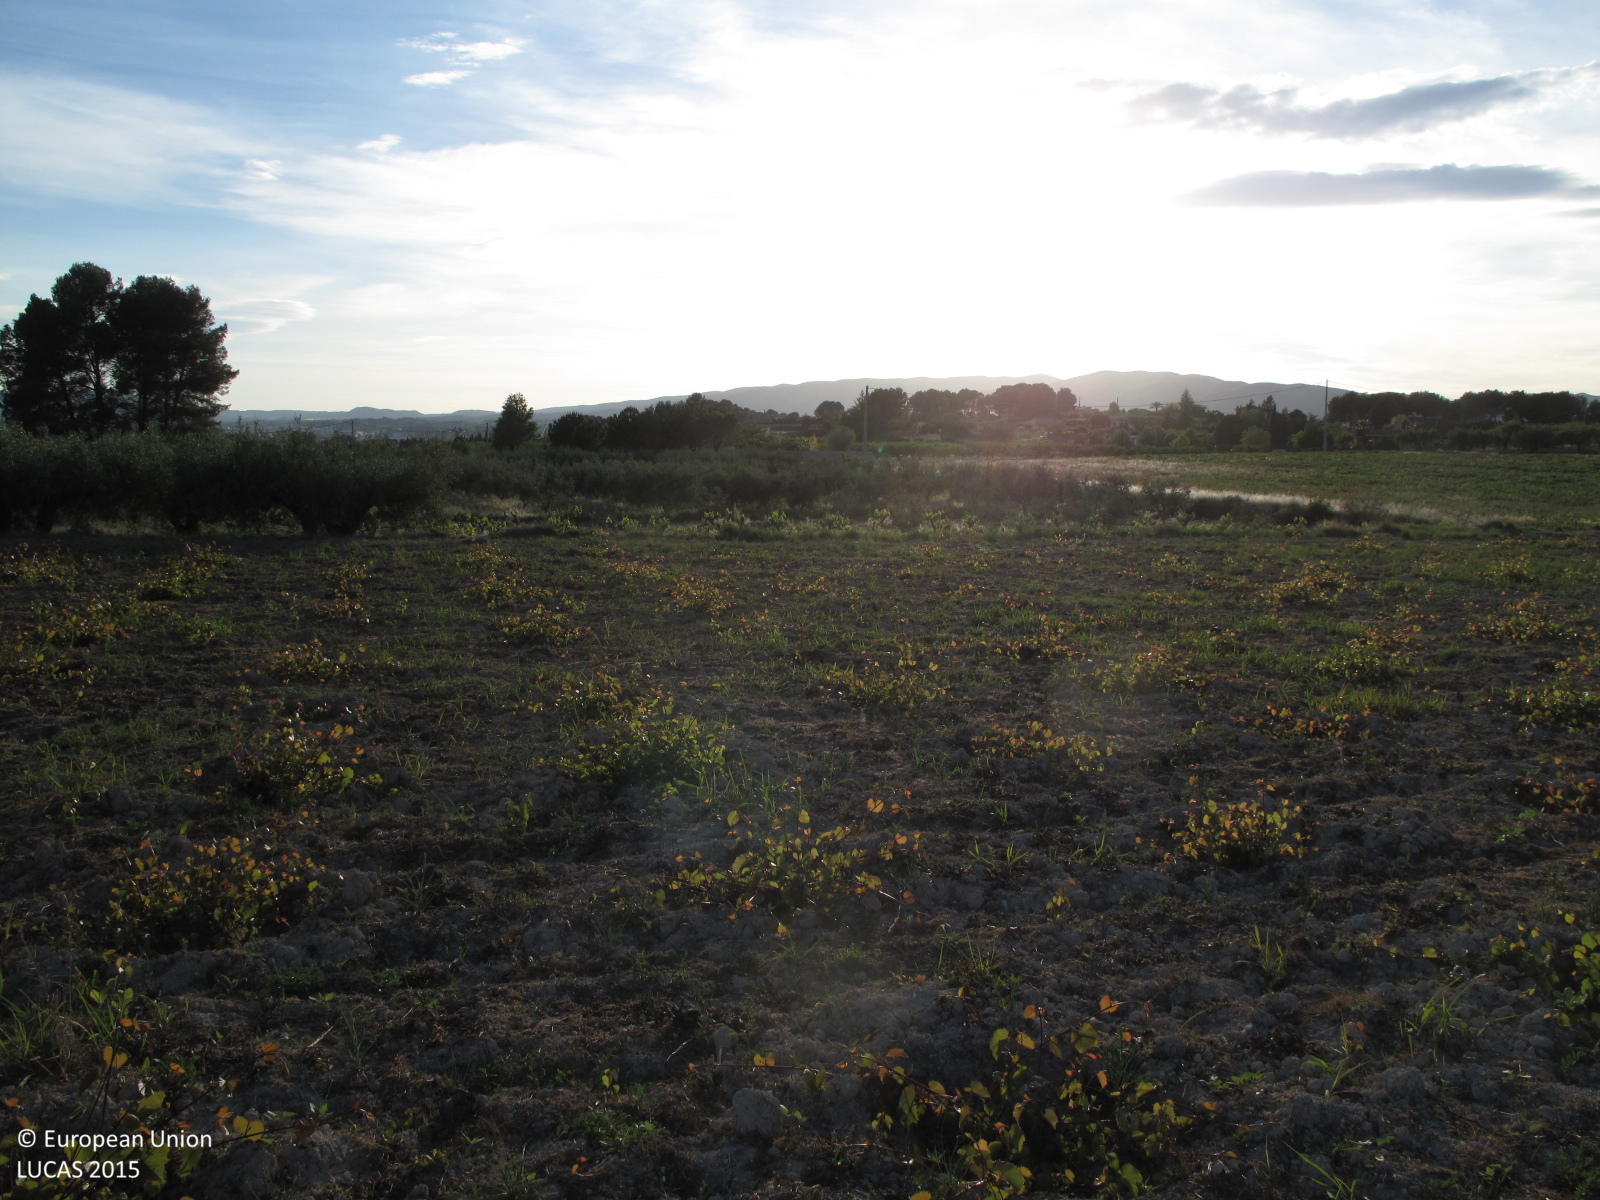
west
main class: Cropland
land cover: Vineyards
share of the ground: < 10 %
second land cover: Spontaneously vegetated surfaces
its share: 25 - 50 %
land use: Agriculture (excluding fallow land and kitchen gardens)
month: May
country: ES
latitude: 38.8388
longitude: -0.5556
